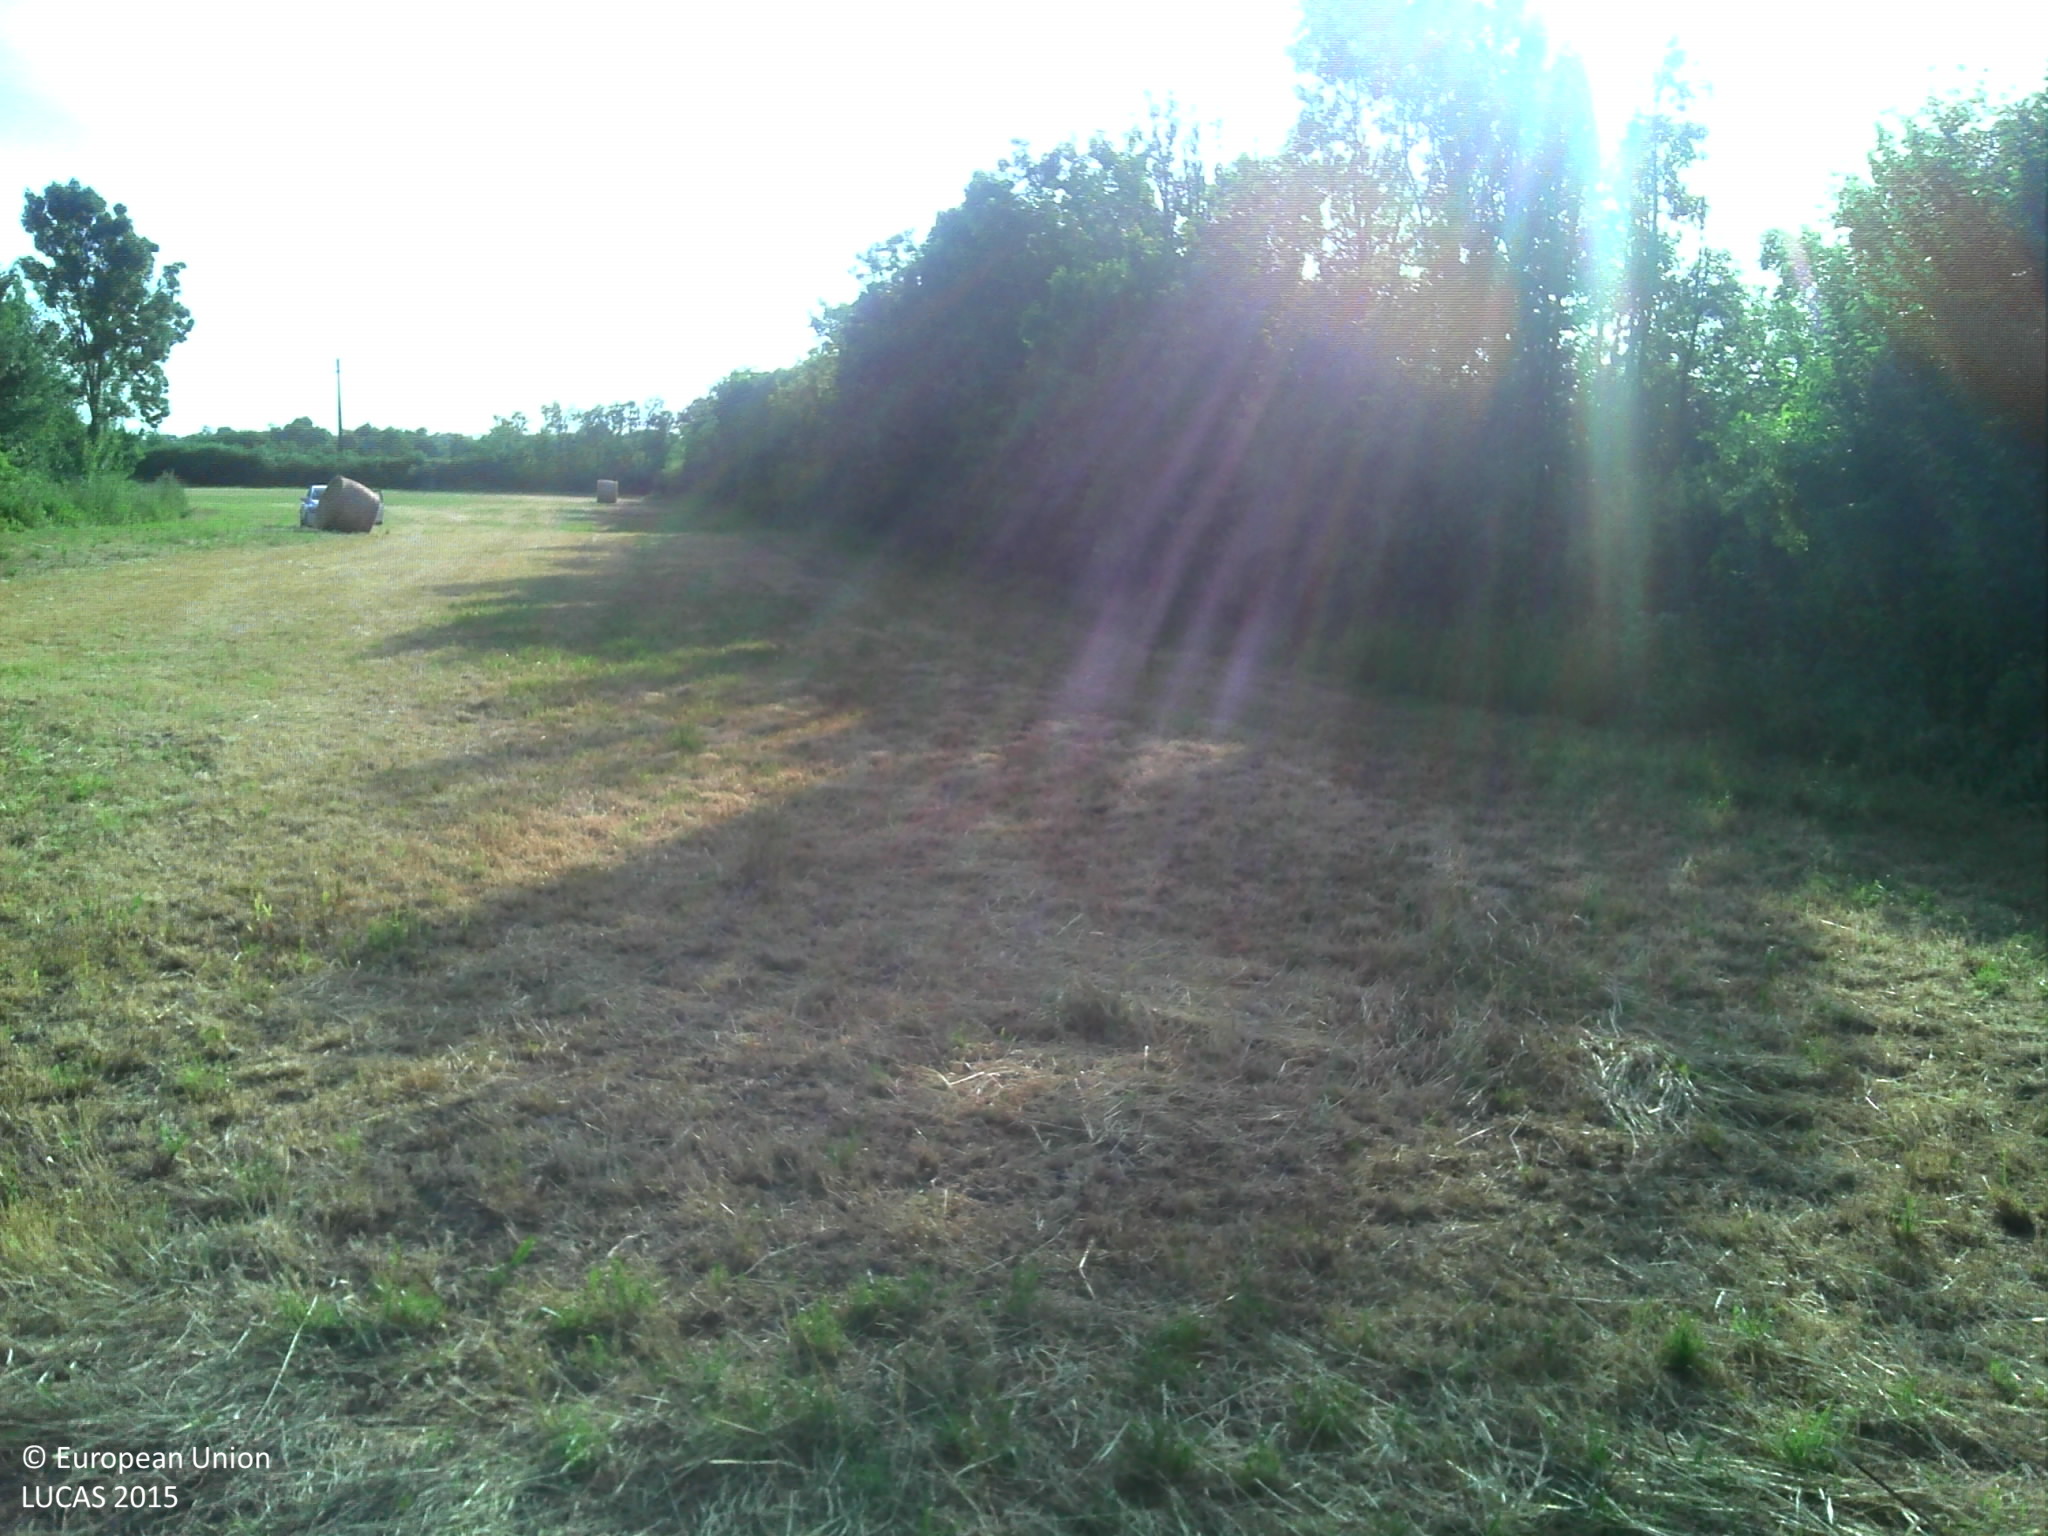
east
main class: Grassland
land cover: Grassland without tree/shrub cover
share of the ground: > 75 %
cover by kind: herbaceous plants 100 %
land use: Agriculture (excluding fallow land and kitchen gardens)
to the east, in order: Grassland without tree/shrub cover; Managed hedges; Grassland without tree/shrub cover; Managed hedges; Grassland without tree/shrub cover; Abandoned hedges; Grassland without tree/shrub cover; Tracks
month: June
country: FR
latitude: 46.0418
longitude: -0.9482
